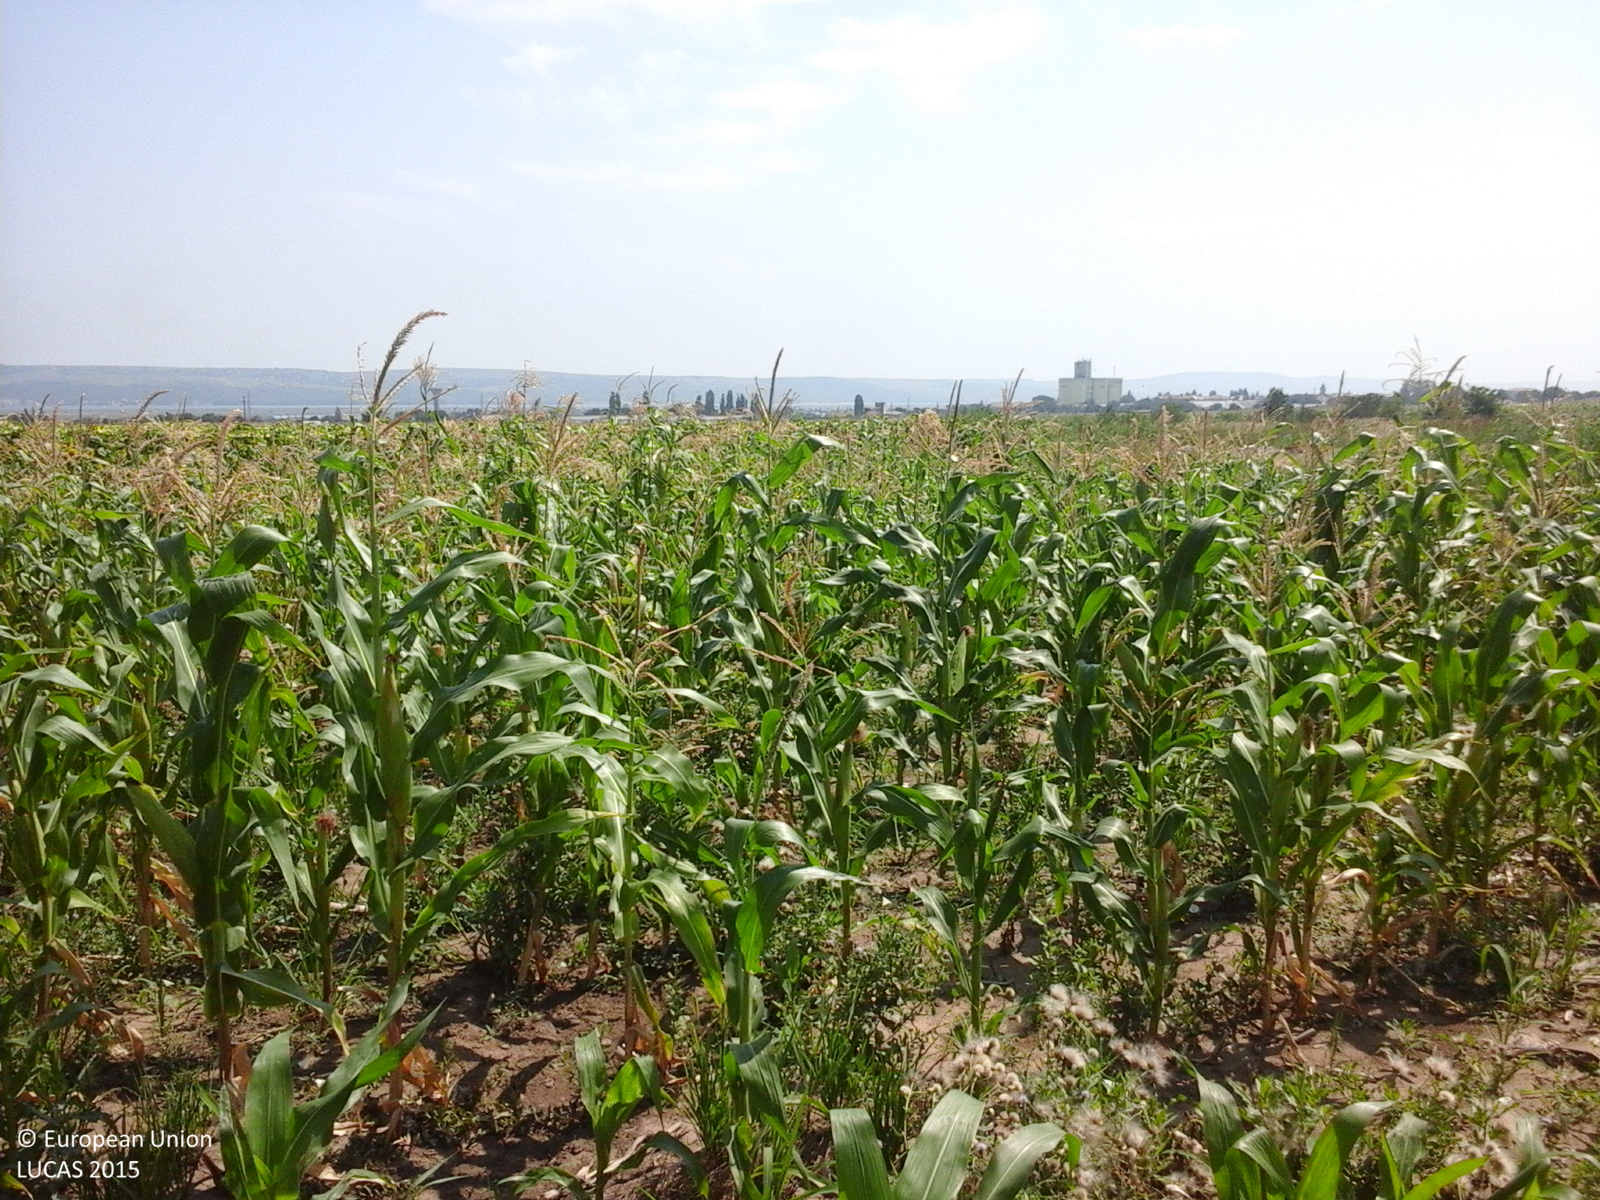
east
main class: Cropland
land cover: Maize
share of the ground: > 75 %
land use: Agriculture (excluding fallow land and kitchen gardens)
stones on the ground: < 10 %
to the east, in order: Maize; Sunflower; Maize; Sunflower; Spontaneously vegetated surfaces; Maize; Shruby margins; Other bare soil
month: August
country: RO
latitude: 46.2135
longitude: 27.0900
